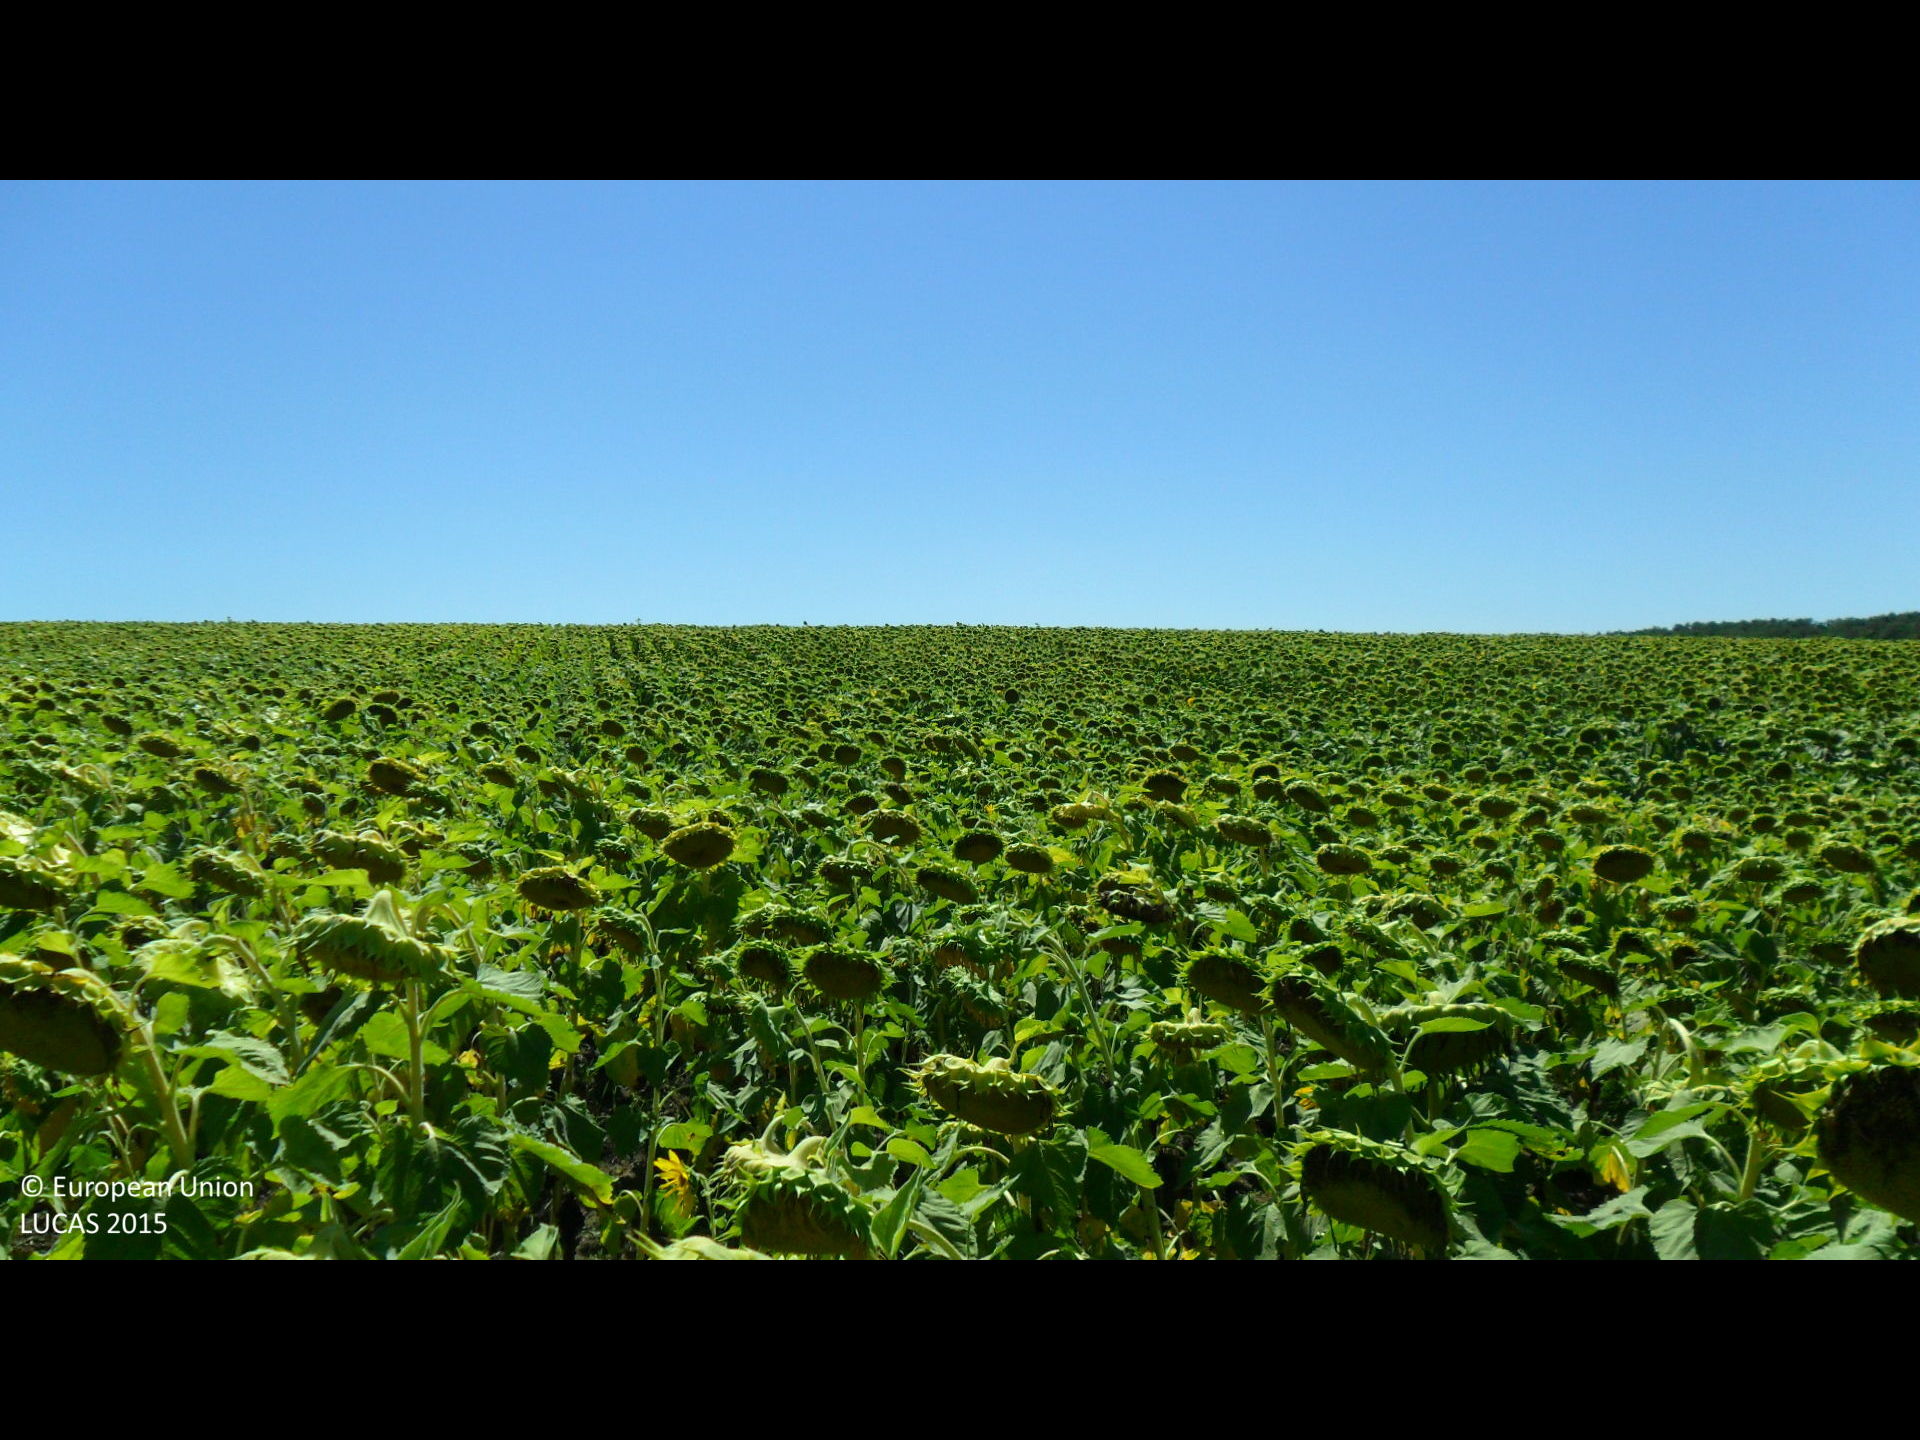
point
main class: Cropland
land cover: Sunflower
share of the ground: > 75 %
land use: Agriculture (excluding fallow land and kitchen gardens)
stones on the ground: < 10 %
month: September
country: BG
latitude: 43.1214
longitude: 26.4332
